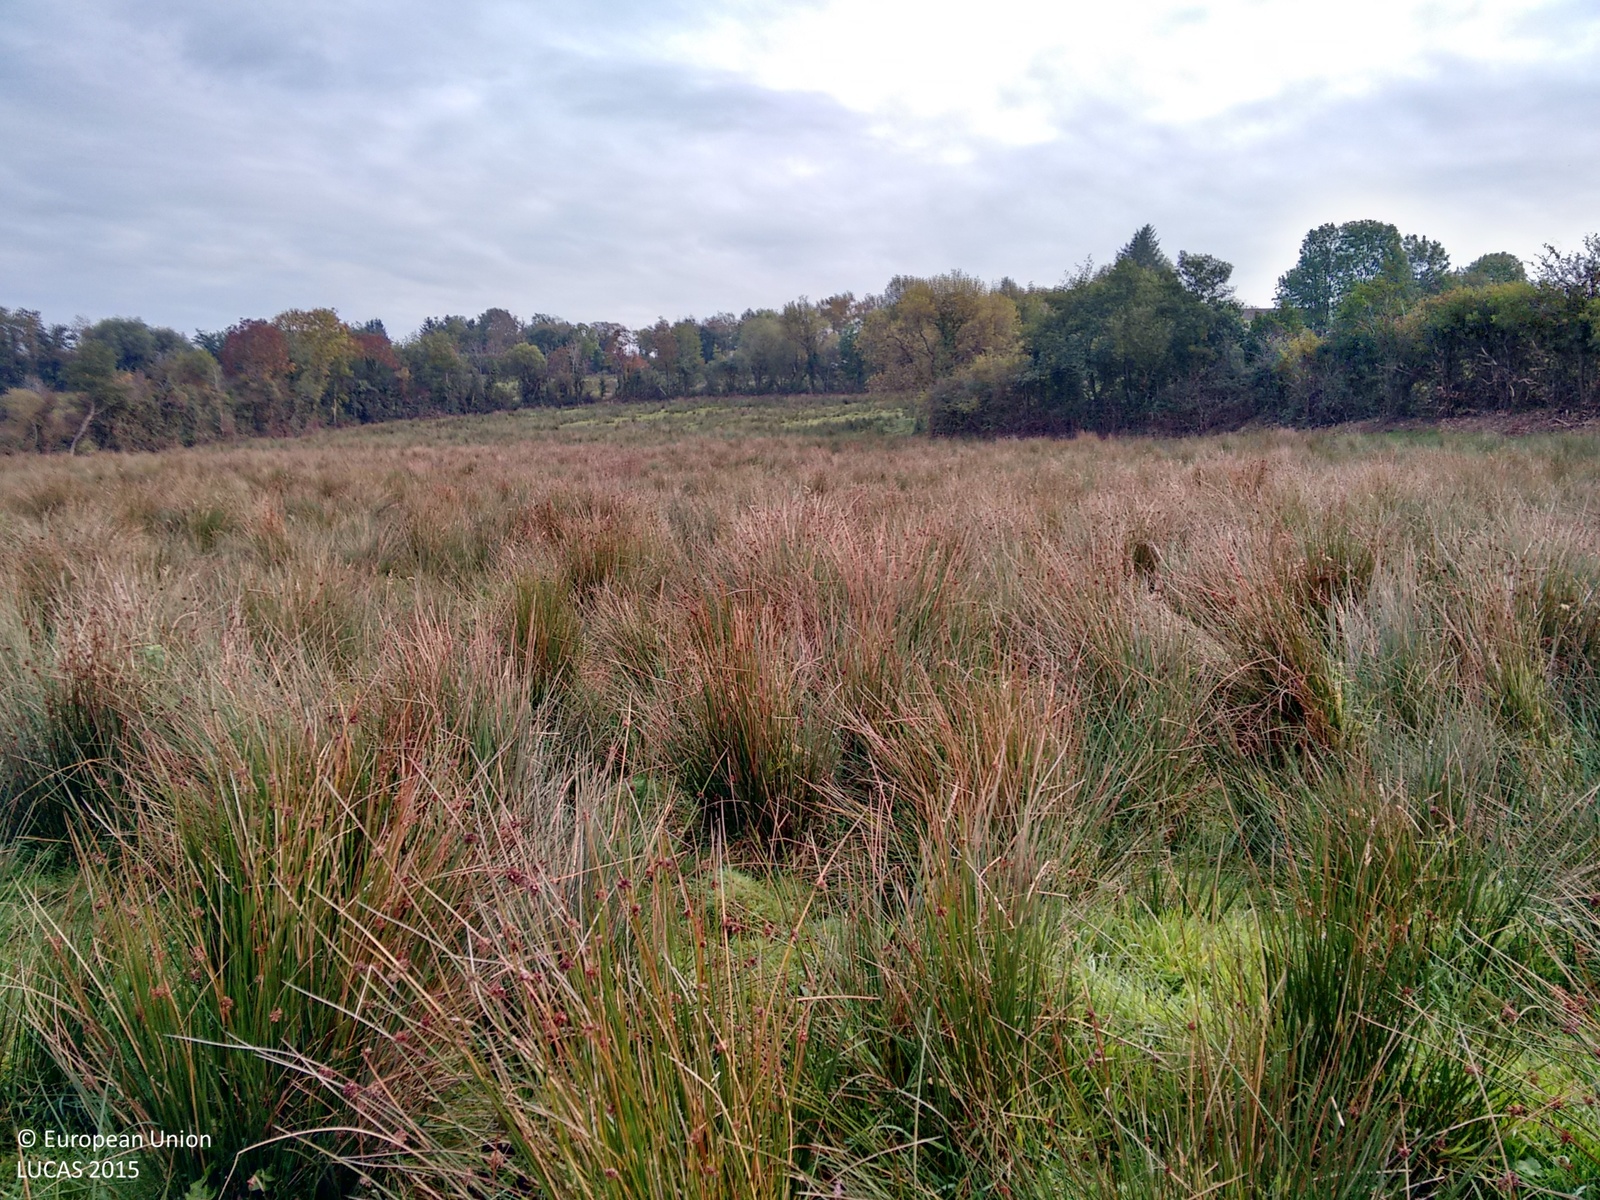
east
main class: Grassland
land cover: Grassland without tree/shrub cover
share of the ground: > 75 %
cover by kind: herbaceous plants 100 %
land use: Agriculture (excluding fallow land and kitchen gardens)
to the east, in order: Grassland without tree/shrub cover; Abandoned hedges; Grassland without tree/shrub cover; Abandoned hedges; Grassland without tree/shrub cover; Abandoned hedges; Grassland without tree/shrub cover; Managed hedges; Electric lines; Grass margins; Paved roads, cycling and walking lanes; Grass margins; Managed hedges; Fences; Ditches and canals; Grassland without tree/shrub cover; Electric lines; Grassland without tree/shrub cover
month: October
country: GB
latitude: 54.3571
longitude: -7.7848
